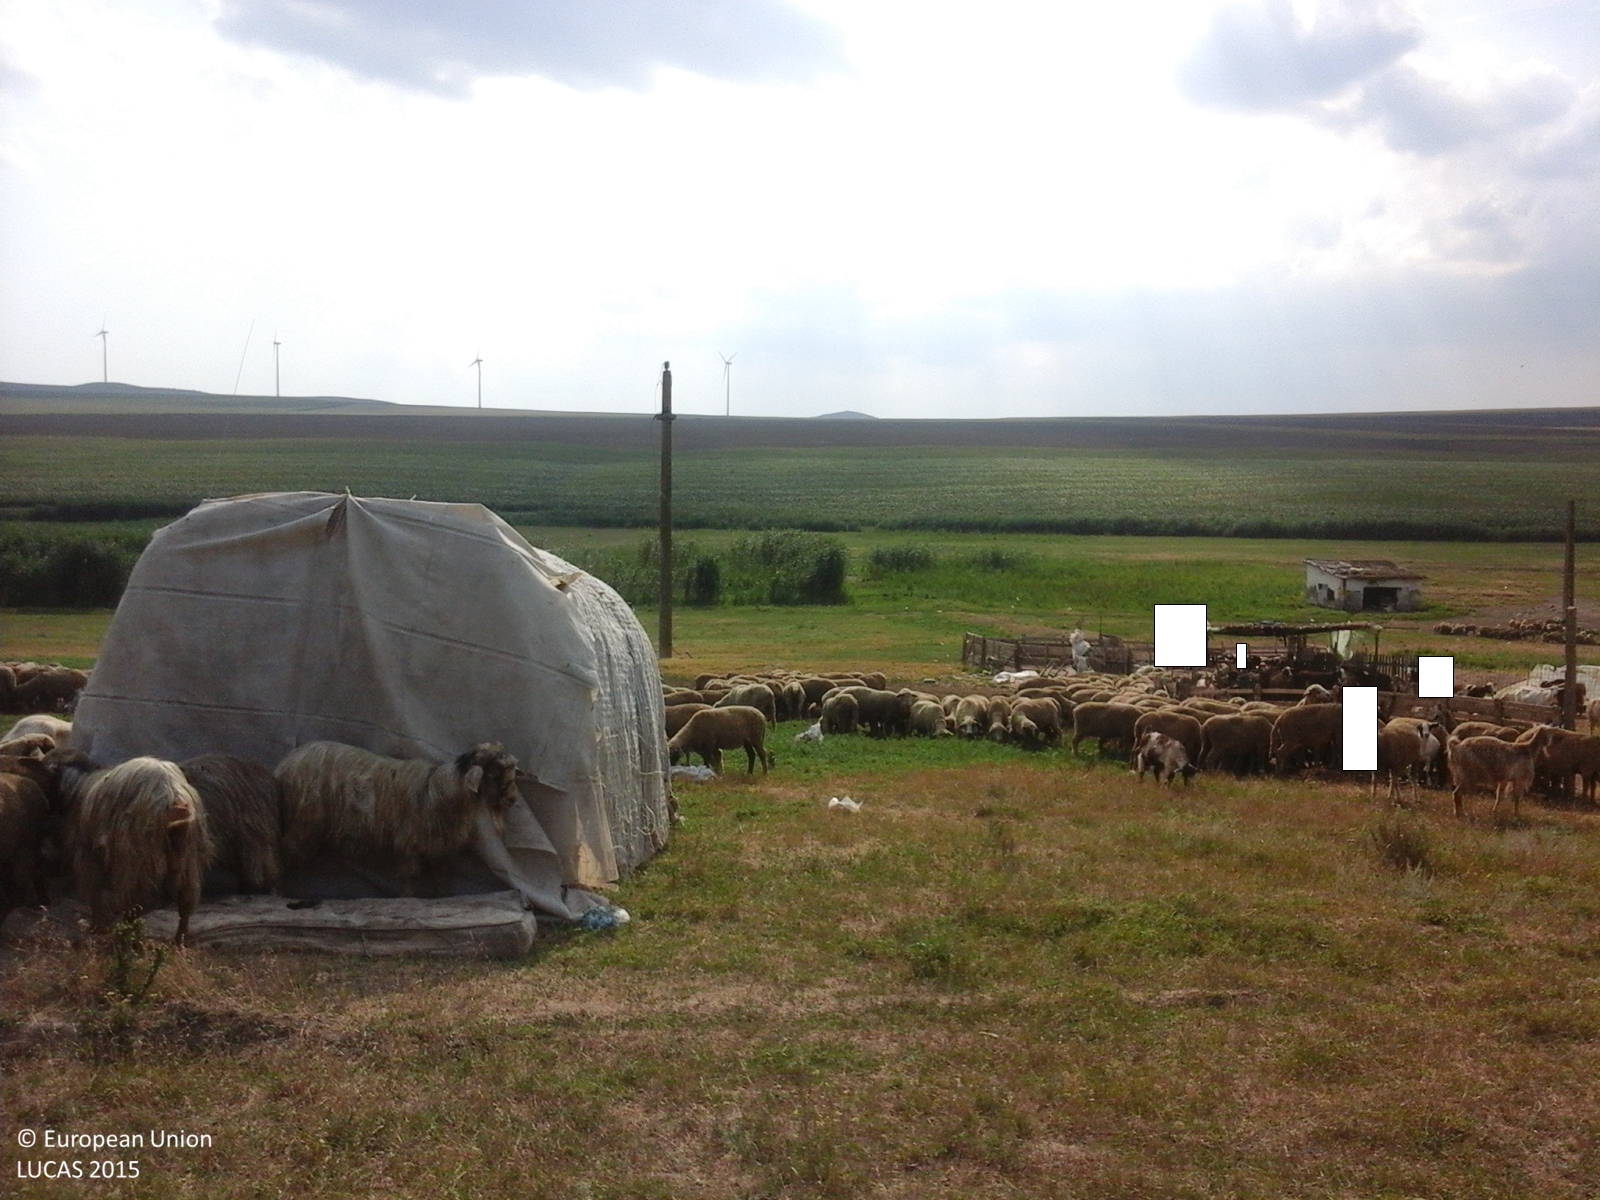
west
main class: Grassland
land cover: Grassland without tree/shrub cover
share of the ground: > 75 %
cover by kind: herbaceous plants 100 %
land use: Agriculture (excluding fallow land and kitchen gardens)
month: July
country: RO
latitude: 45.0795
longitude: 28.8539
